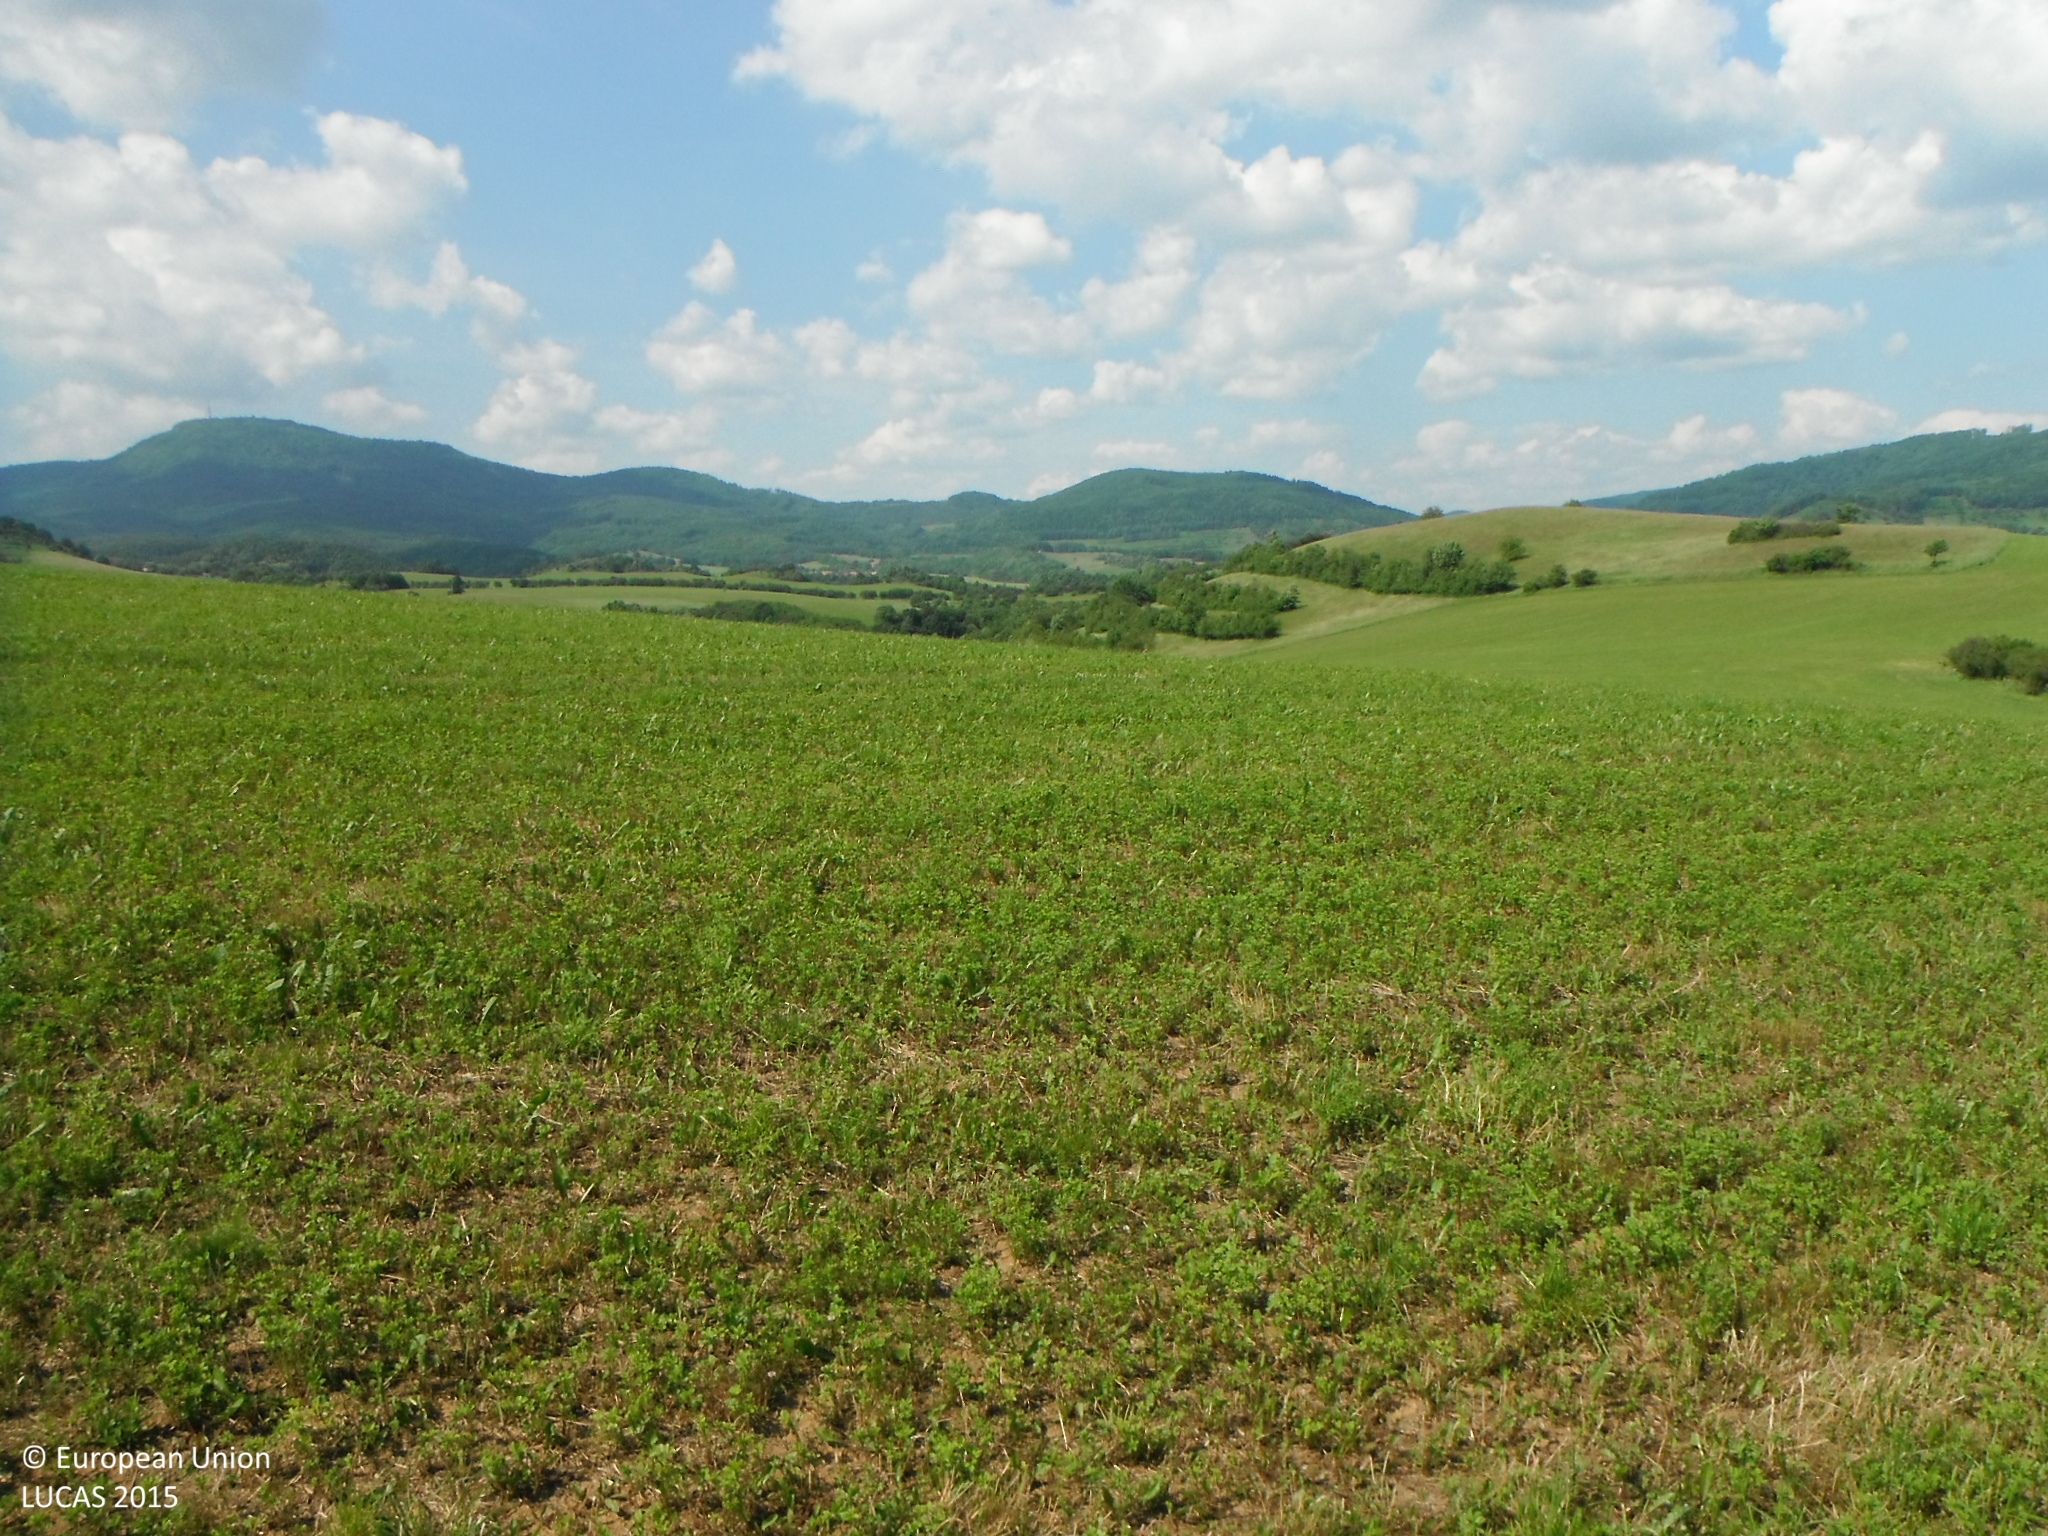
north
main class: Cropland
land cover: Other leguminous and mixtures for fodder
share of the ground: > 75 %
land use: Agriculture (excluding fallow land and kitchen gardens)
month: May
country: SK
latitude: 48.3507
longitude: 18.9122
